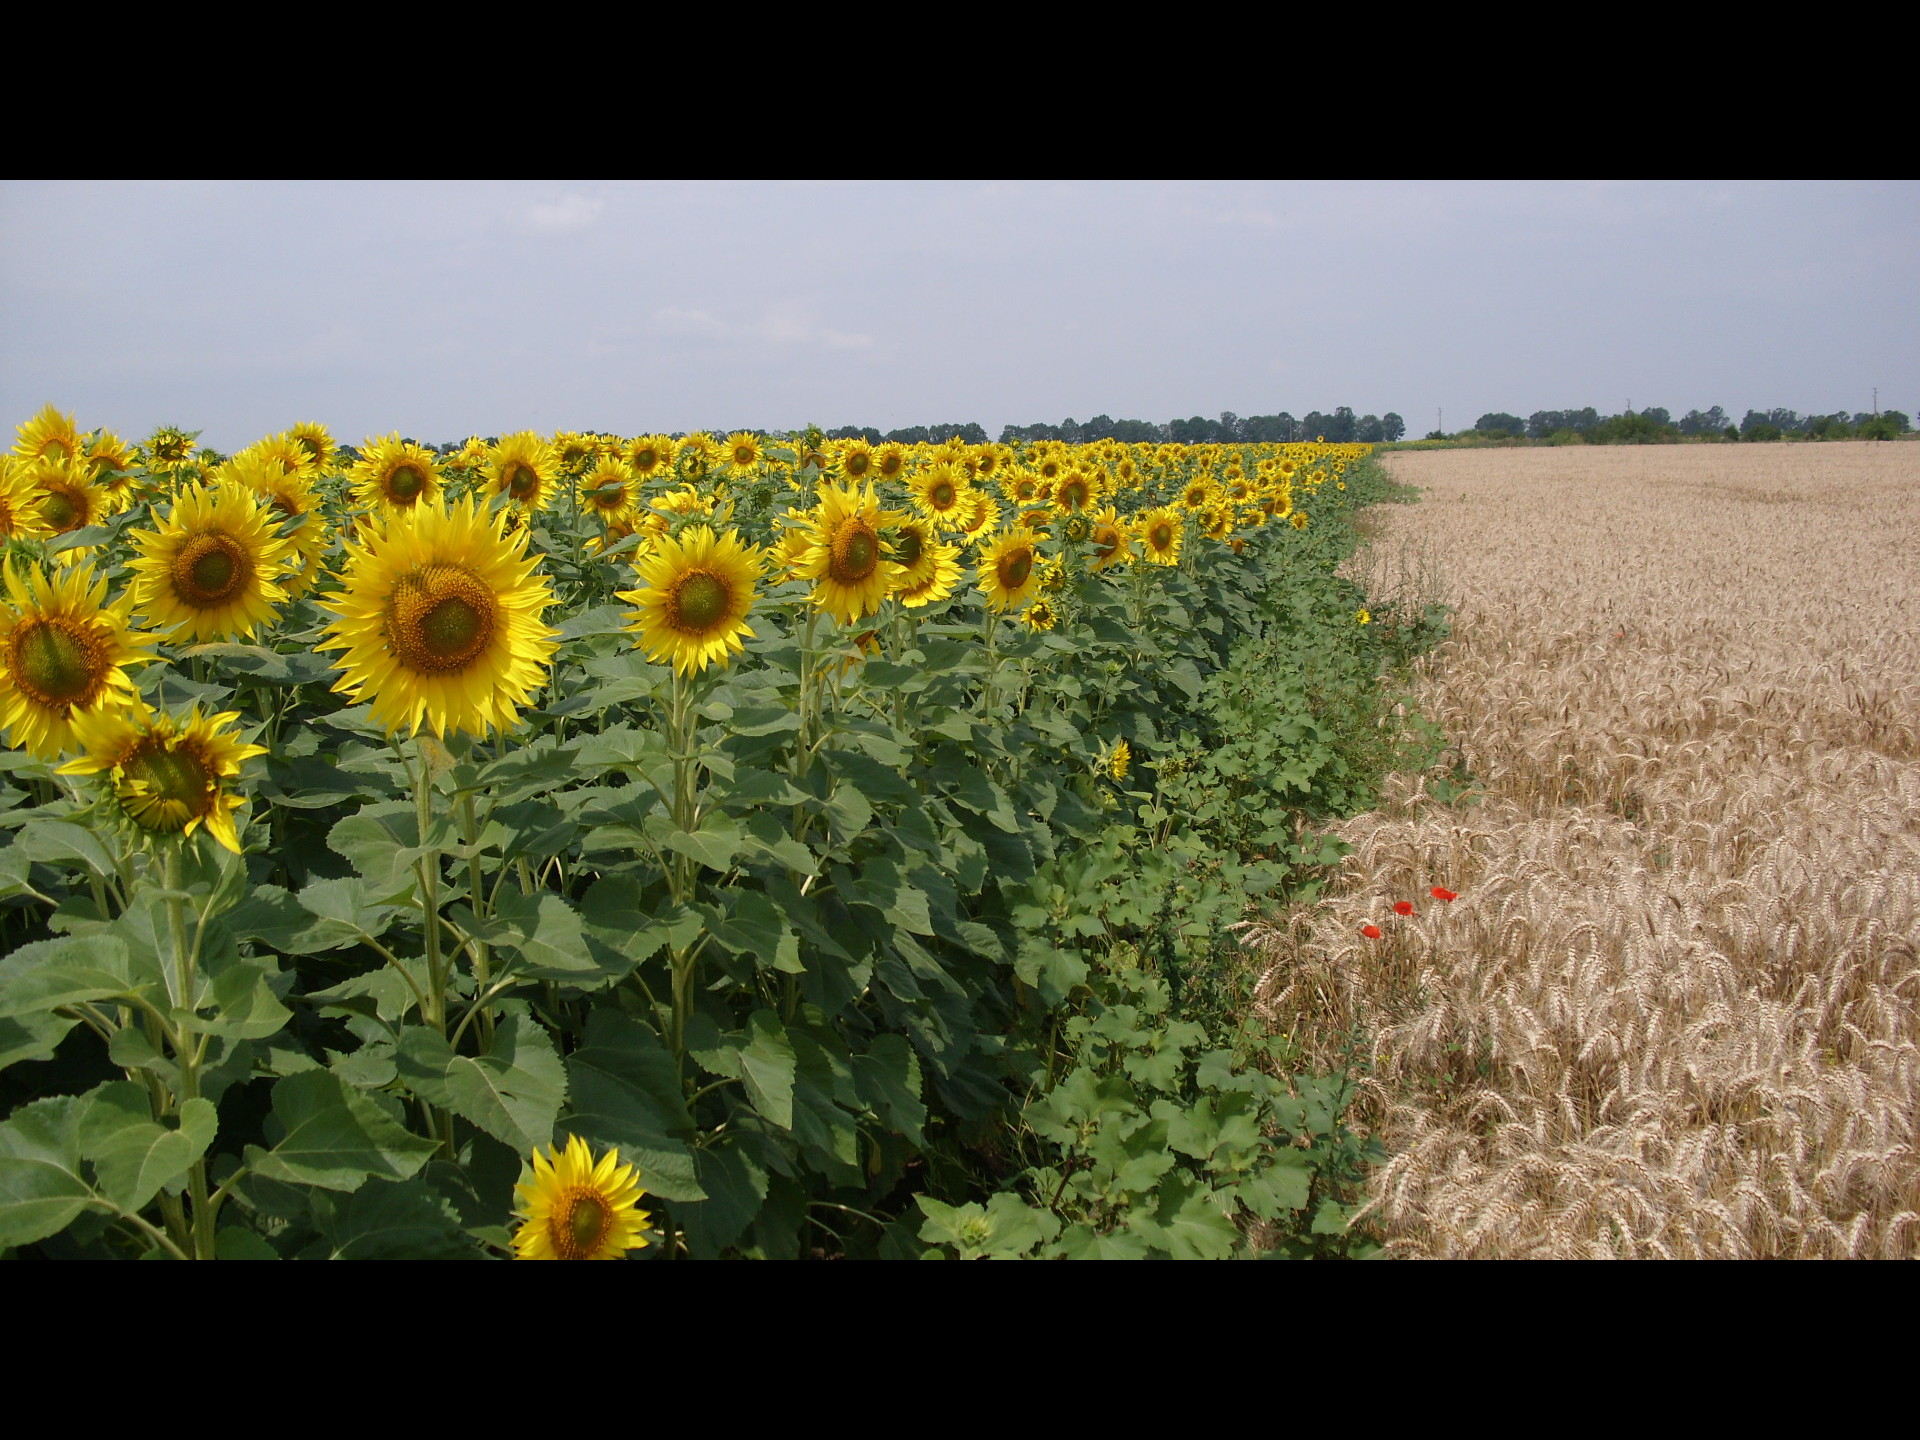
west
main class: Cropland
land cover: Sunflower
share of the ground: > 75 %
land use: Agriculture (excluding fallow land and kitchen gardens)
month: June
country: BG
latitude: 43.6788
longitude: 23.2529
